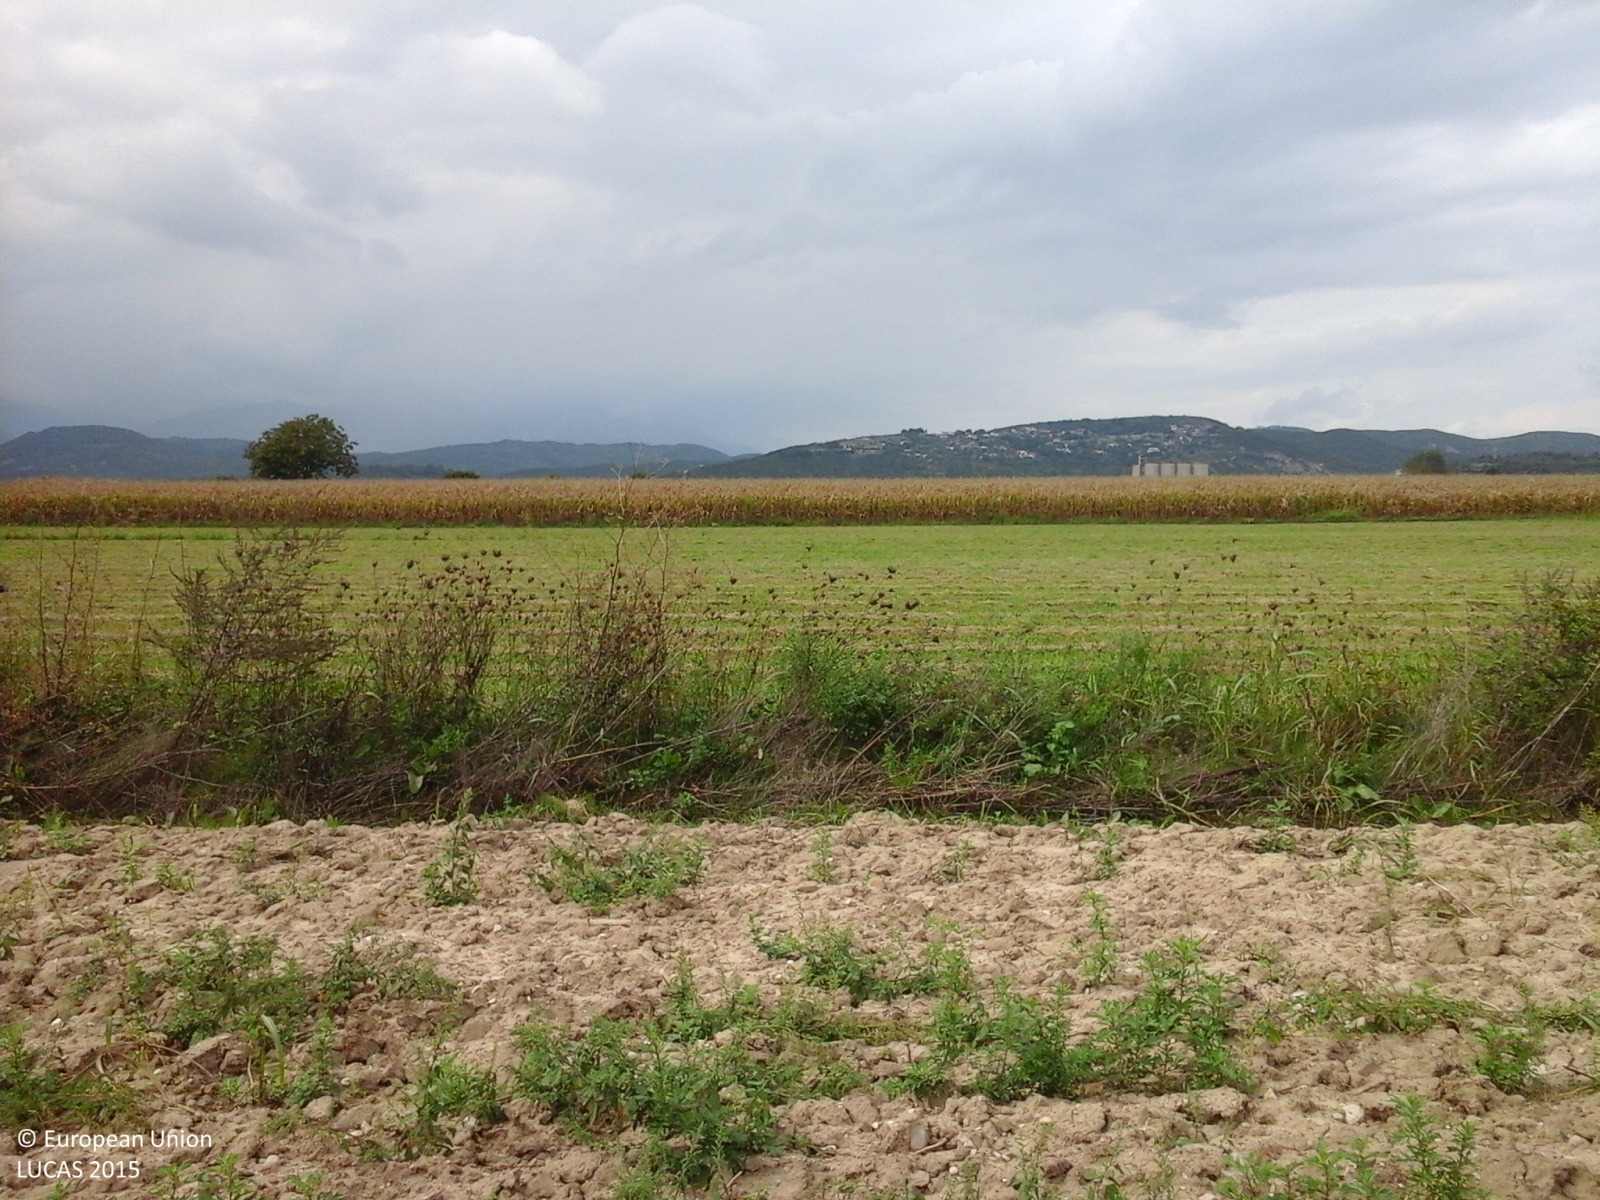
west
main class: Grassland
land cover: Spontaneously vegetated surfaces
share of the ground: 25 - 50 %
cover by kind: unconsolidated bare surface 65 %, herbaceous plants 35 %
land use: Fallow land
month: October
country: GR
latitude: 40.0419
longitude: 20.7293
